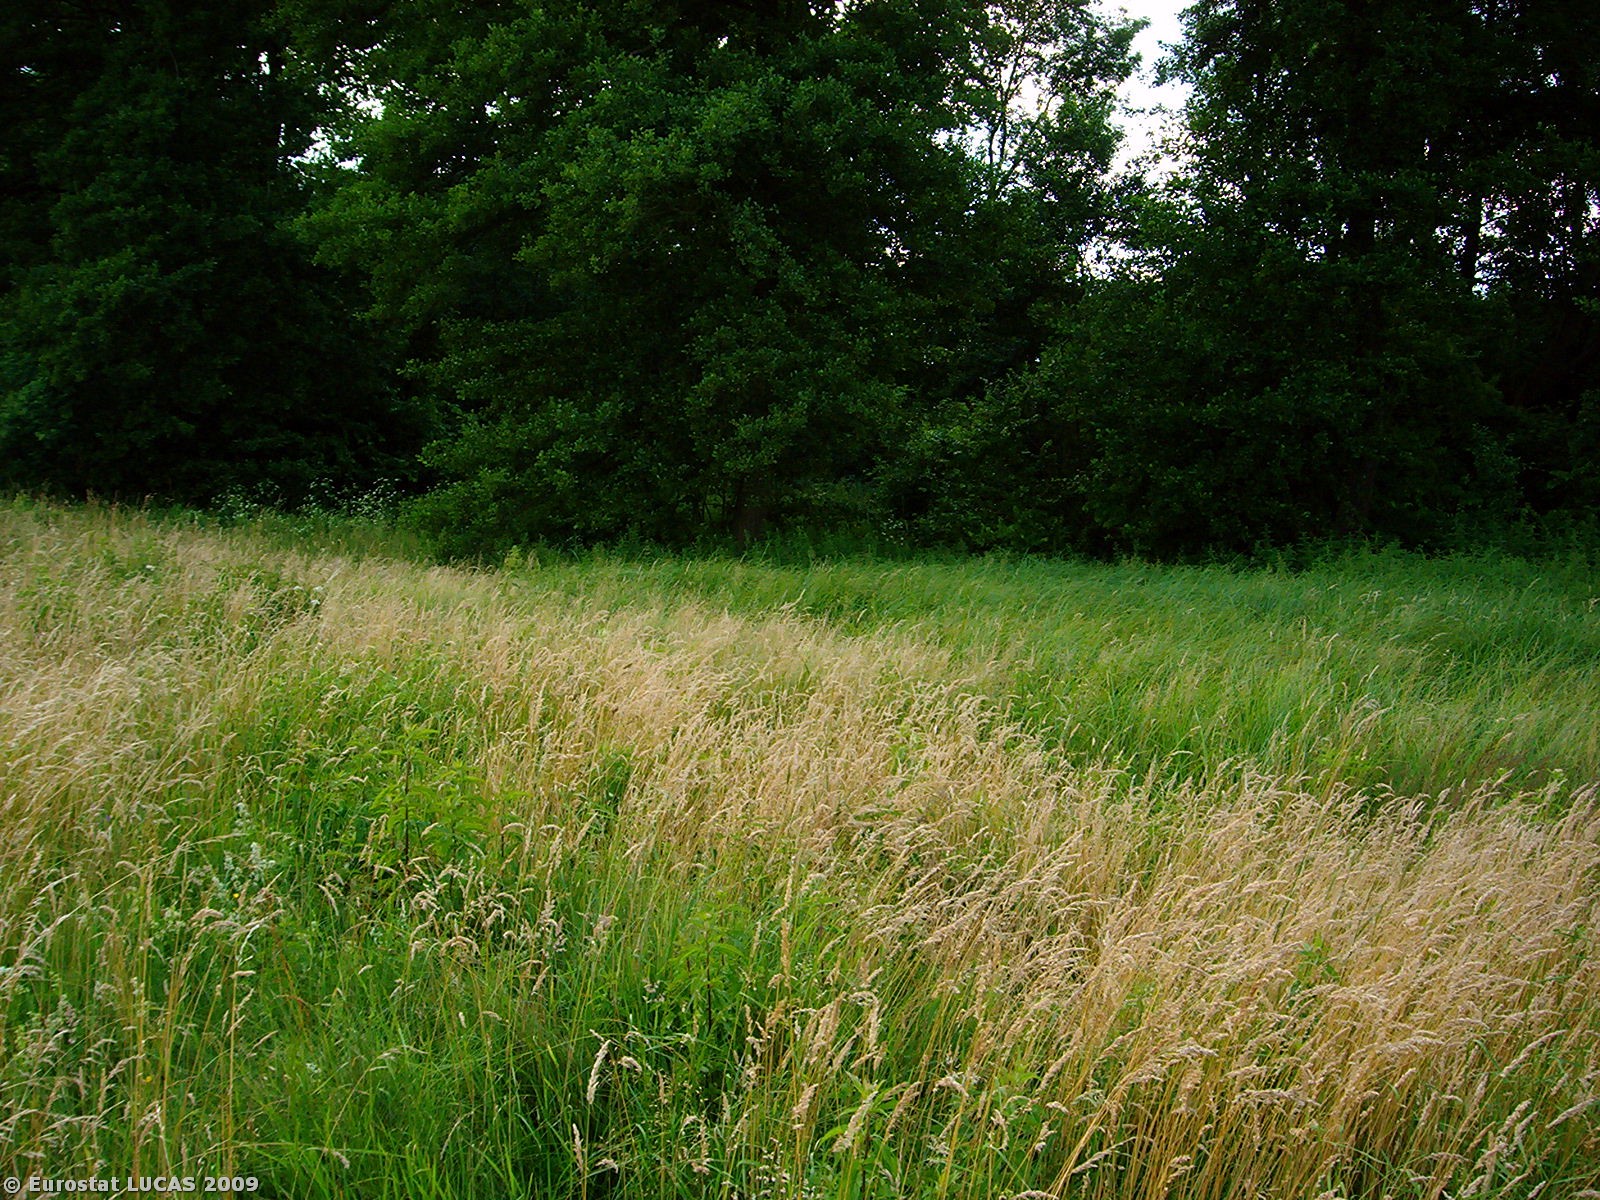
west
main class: Grassland
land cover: Grassland without tree/shrub cover
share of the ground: > 75 %
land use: Agriculture (excluding fallow land and kitchen gardens)
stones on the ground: < 10 %
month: July
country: PL
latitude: 52.4017
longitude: 15.7221
